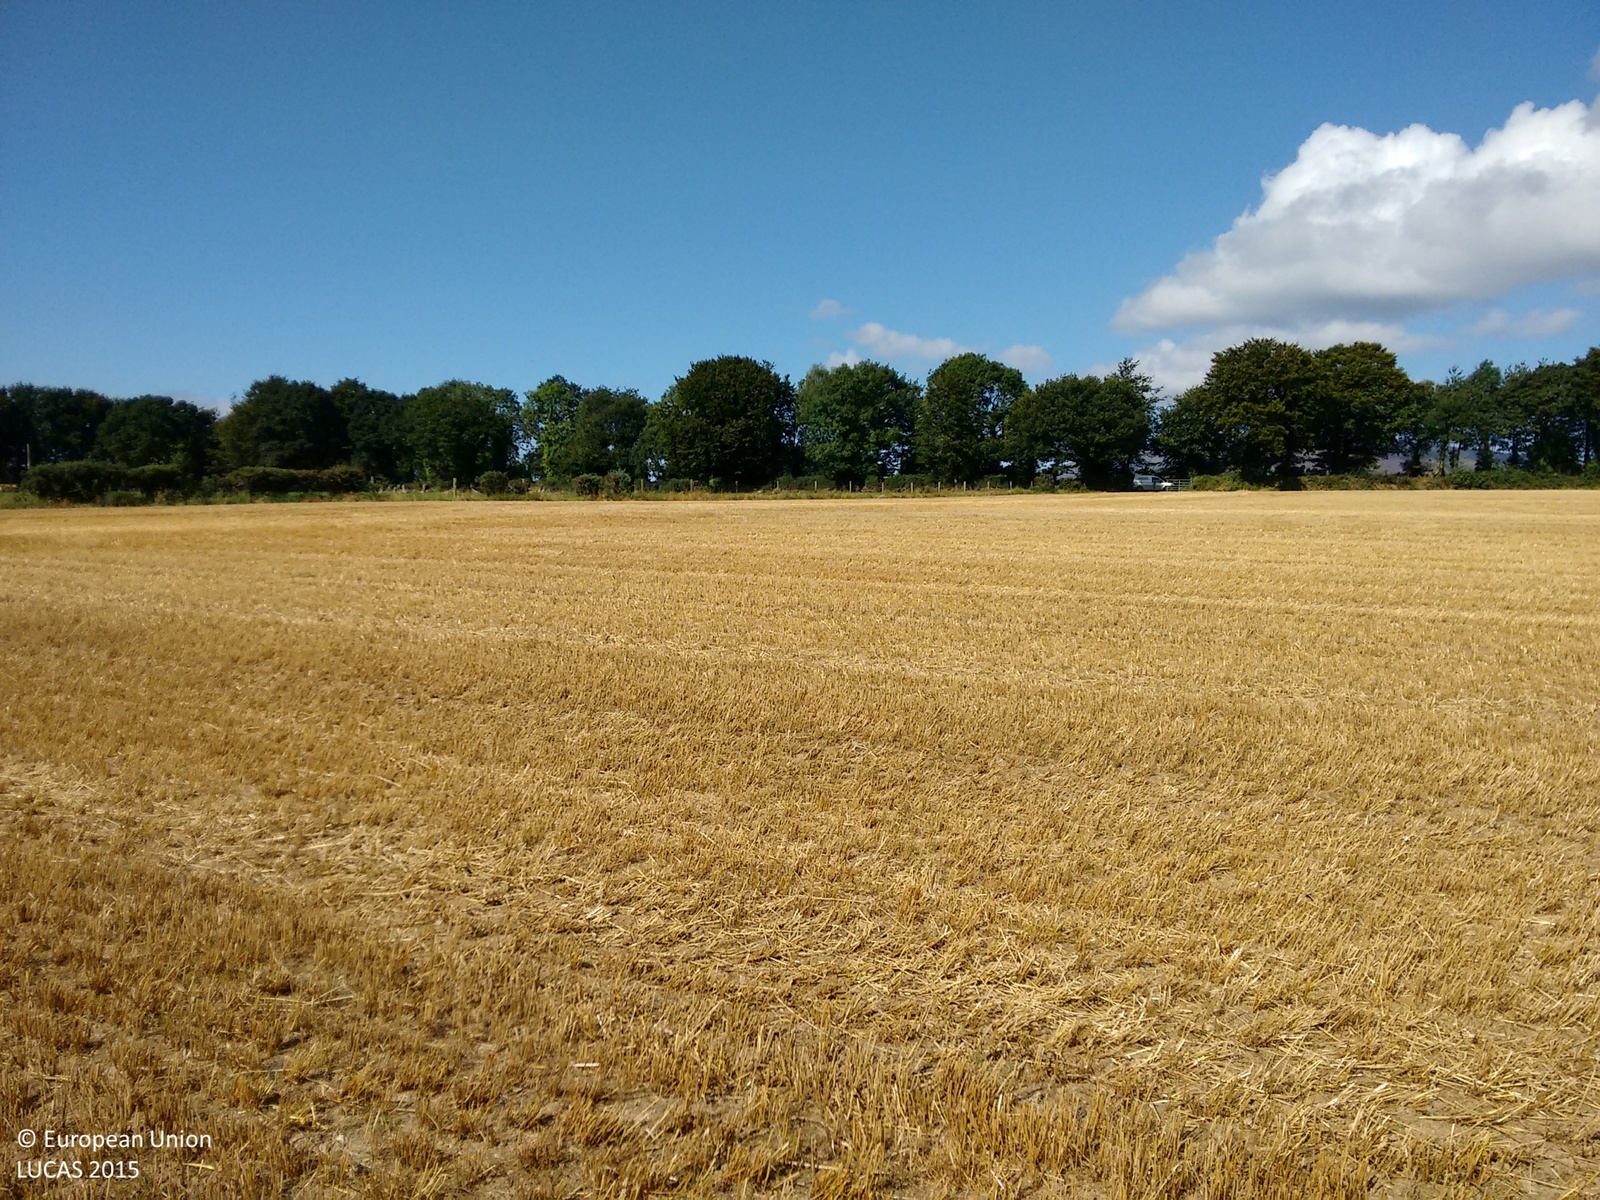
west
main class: Cropland
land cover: Barley
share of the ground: > 75 %
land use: Agriculture (excluding fallow land and kitchen gardens)
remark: Harvested field
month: August
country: IE
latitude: 52.6041
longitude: -6.6552
